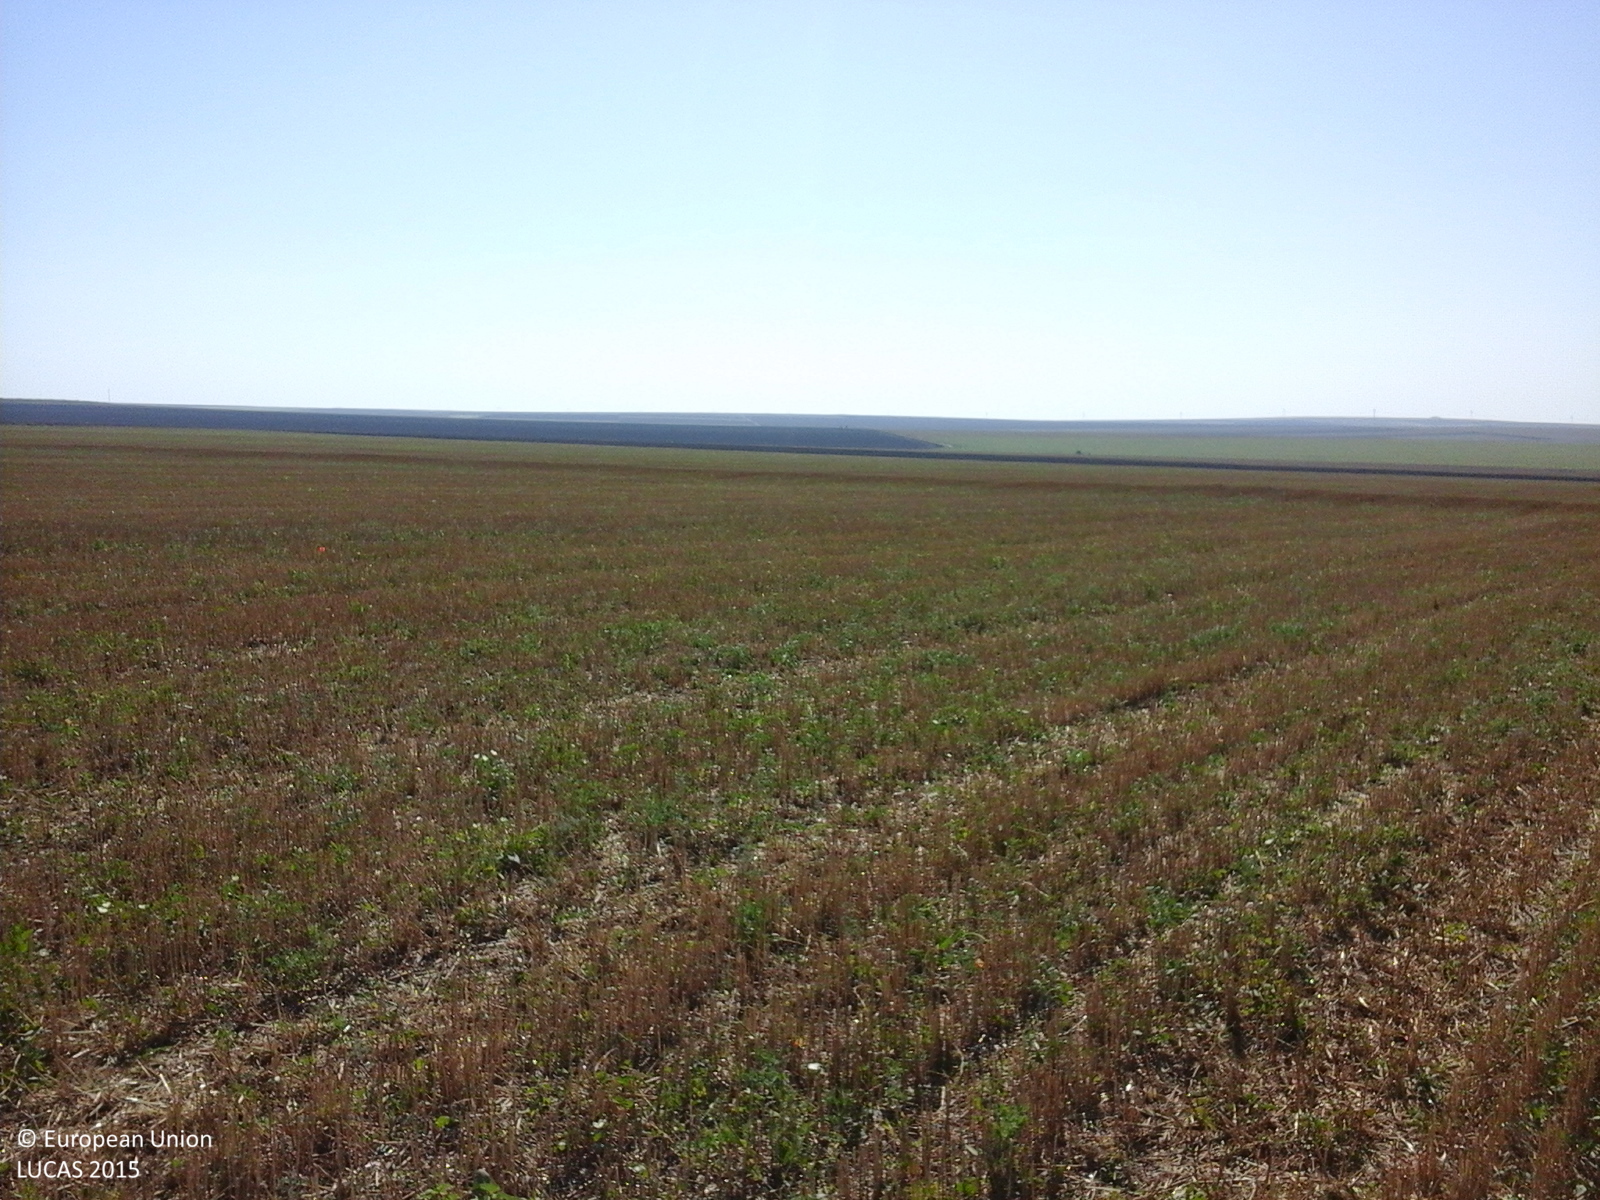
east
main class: Cropland
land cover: Common wheat
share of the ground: > 75 %
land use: Agriculture (excluding fallow land and kitchen gardens)
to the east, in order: Common wheat
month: August
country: RO
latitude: 44.5152
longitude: 28.5035
